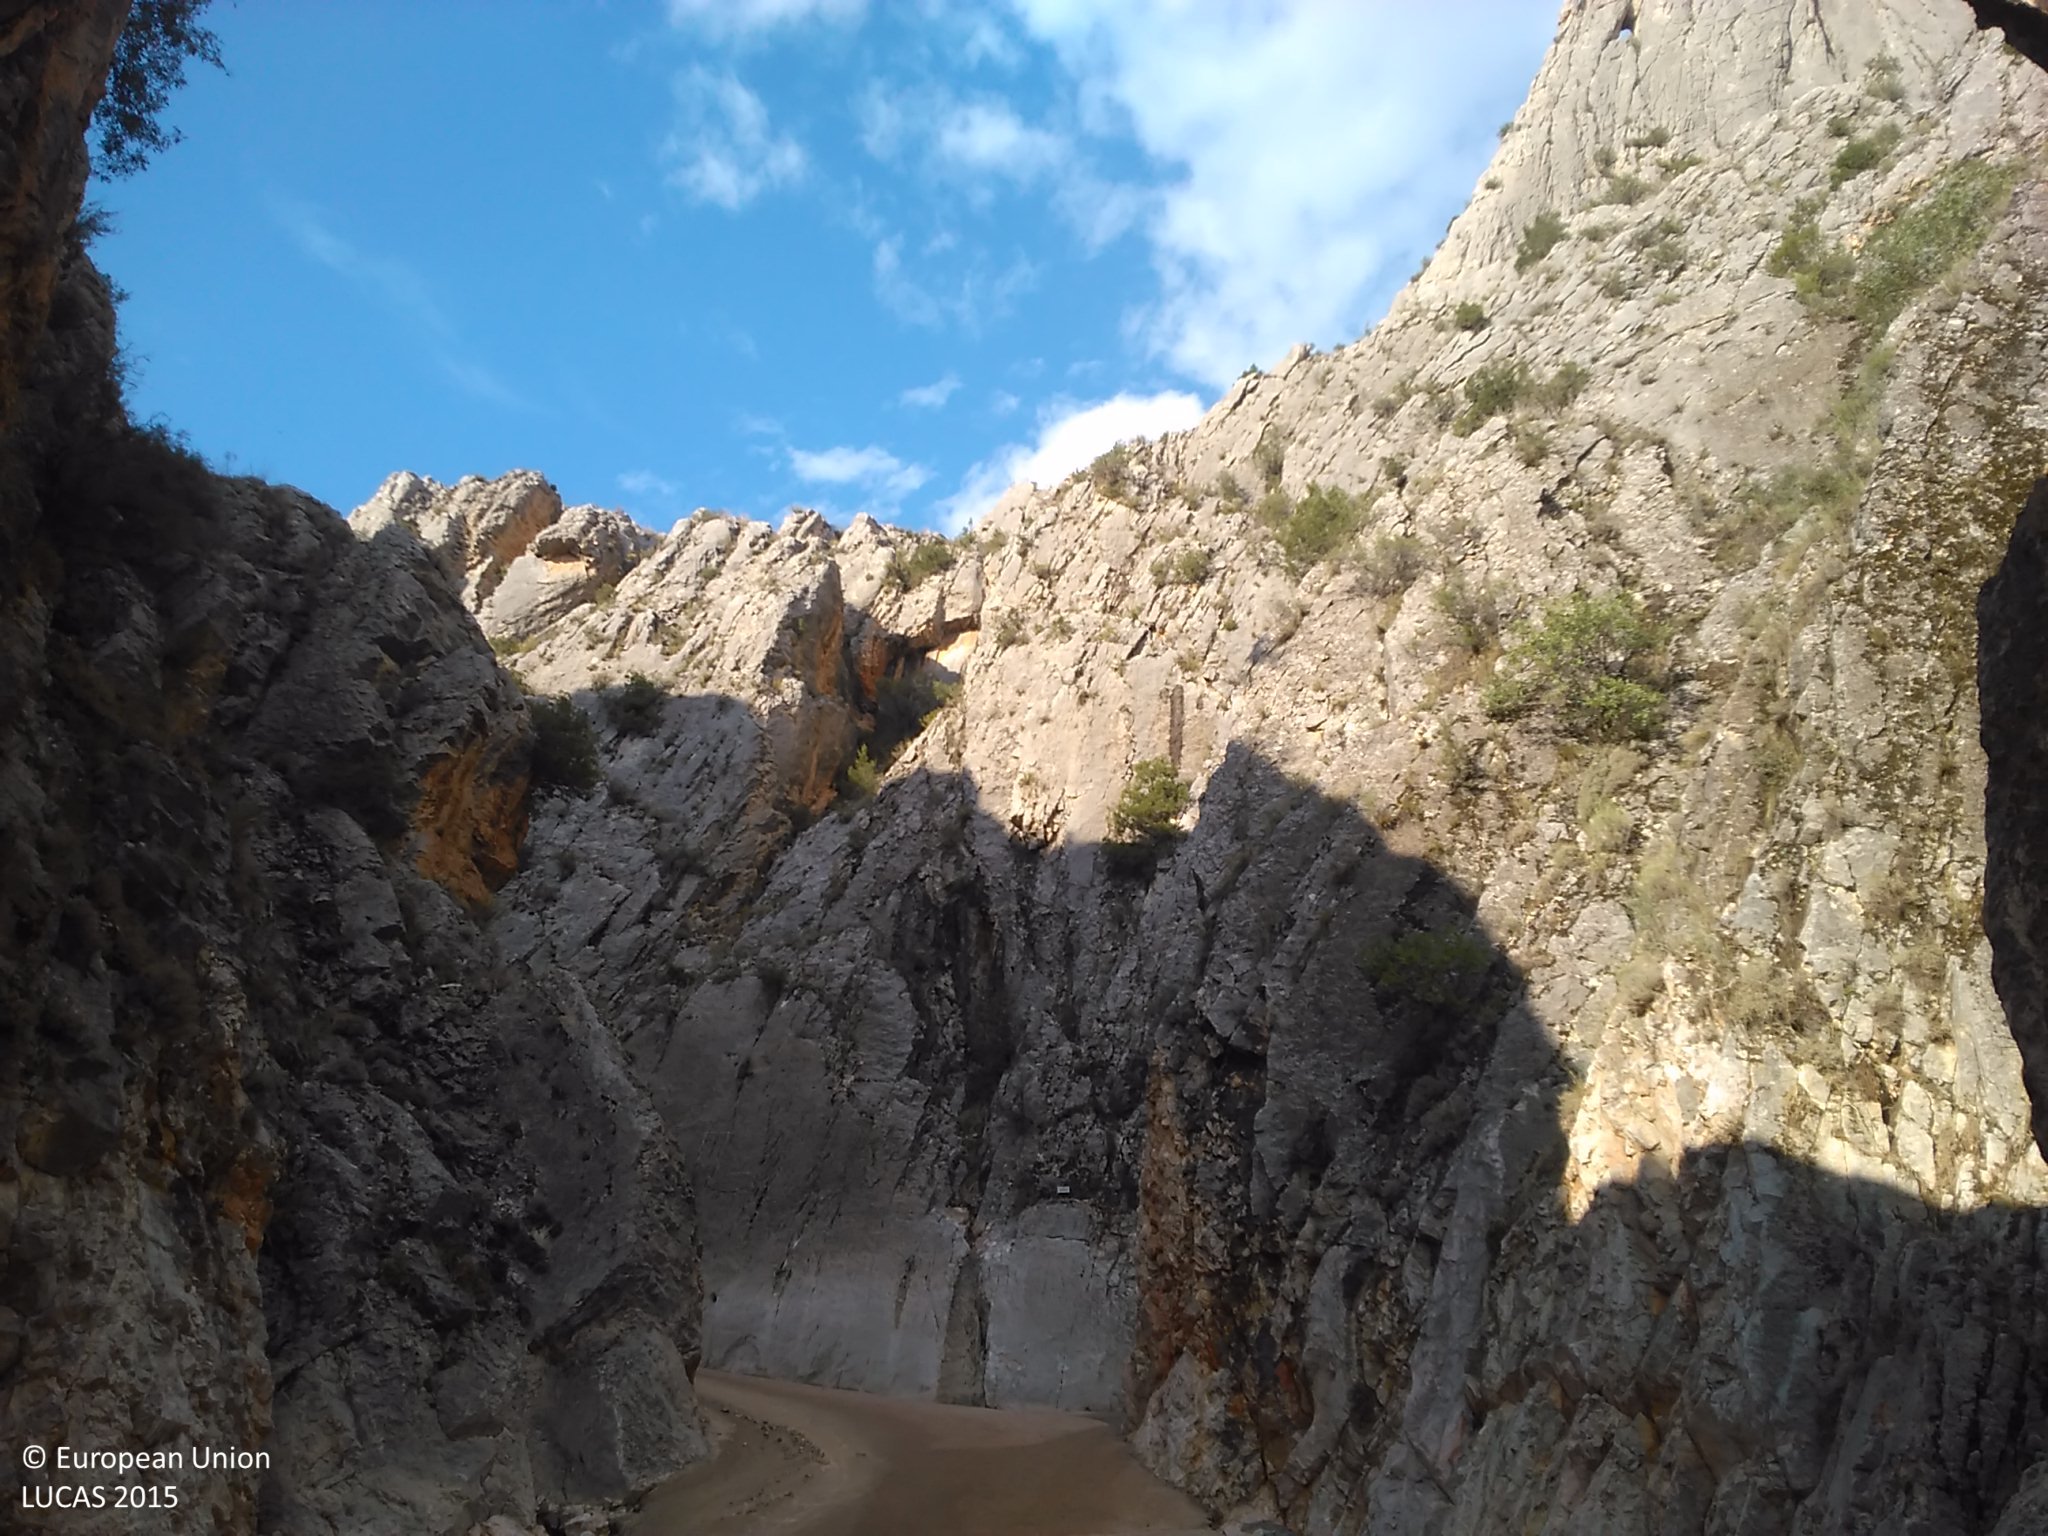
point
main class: Woodland
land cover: Broadleaved woodland
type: broadleaved evergreen forest
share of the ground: 50 - 75 %
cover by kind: broadleaved forest trees 50 %, unconsolidated bare surface 30 %, shrubs 10 %, herbaceous plants 10 %
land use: Semi-natural and natural areas not in use
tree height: < 5 m
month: July
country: ES
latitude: 41.3606
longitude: -1.9462
